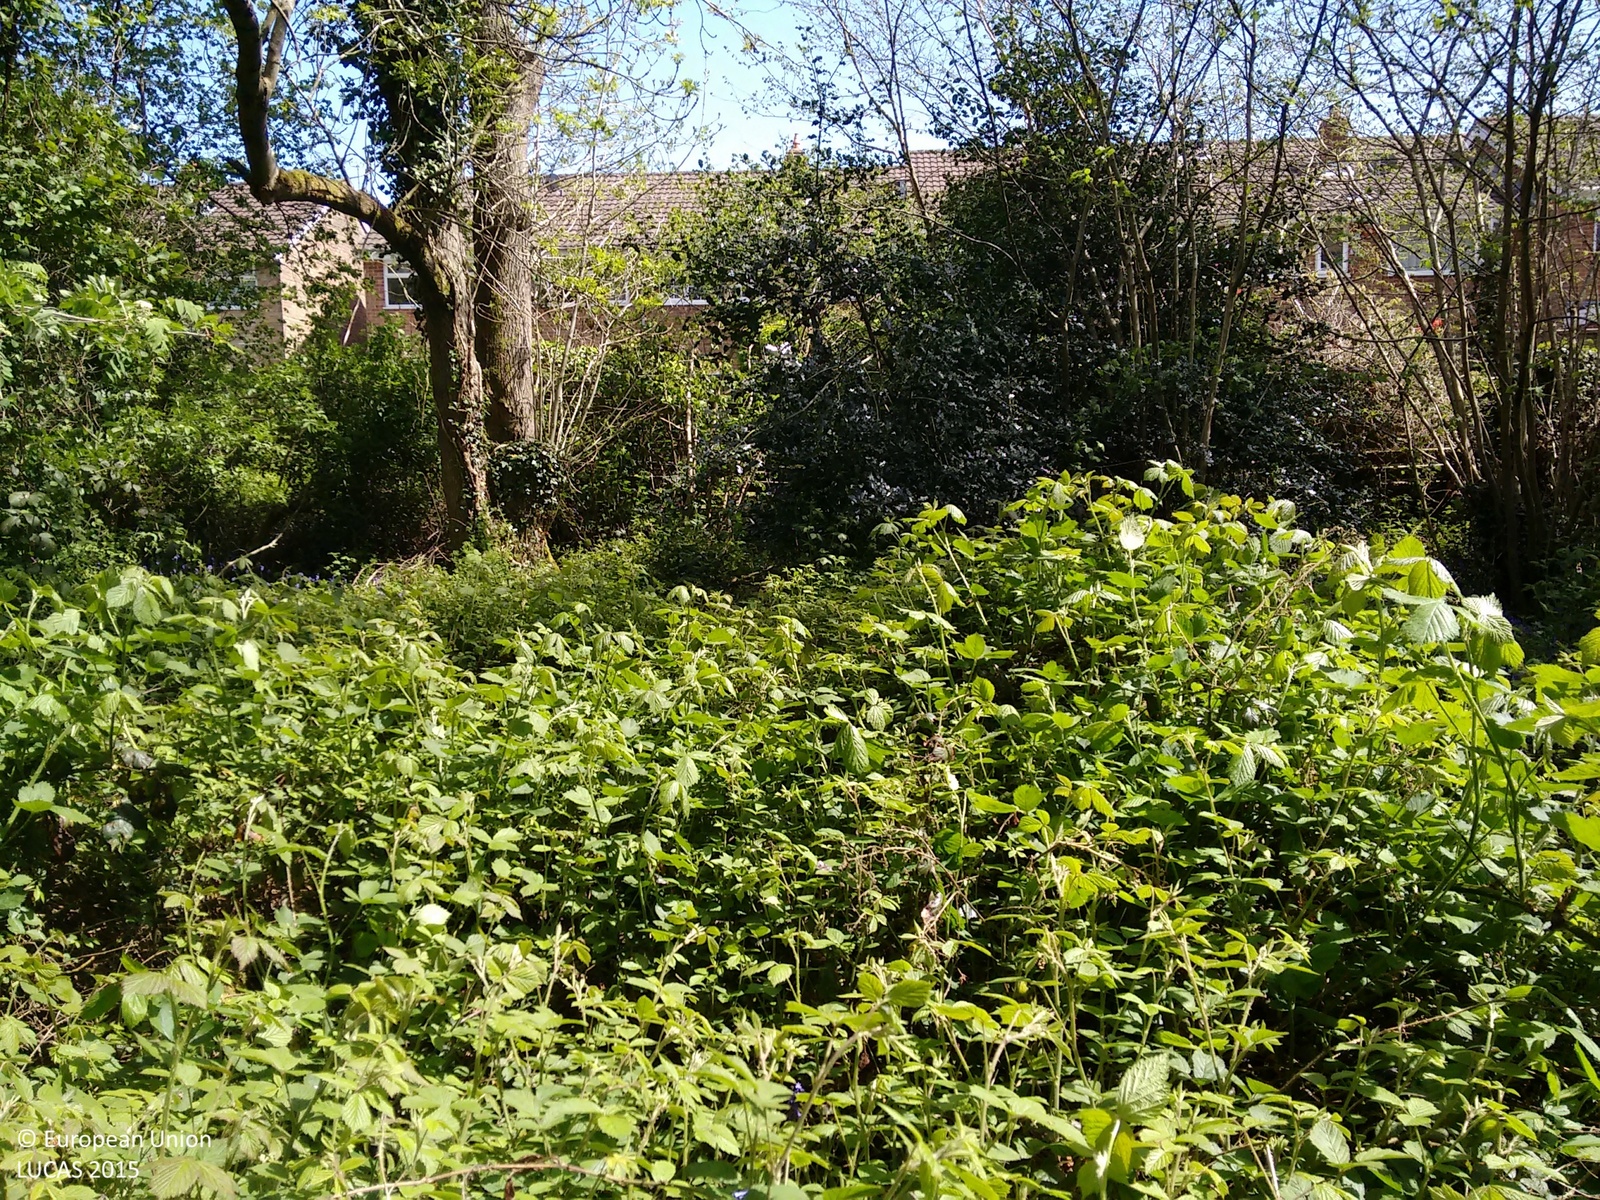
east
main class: Woodland
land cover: Broadleaved woodland
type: mesophytic deciduous forest
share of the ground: > 75 %
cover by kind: broadleaved forest trees 100 %
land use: Amenities, museums, leisure
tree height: > 5 m
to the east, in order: Broadleaved woodland; Artificial constructions in urban areas
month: May
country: GB
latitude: 50.8280
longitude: -1.3930
